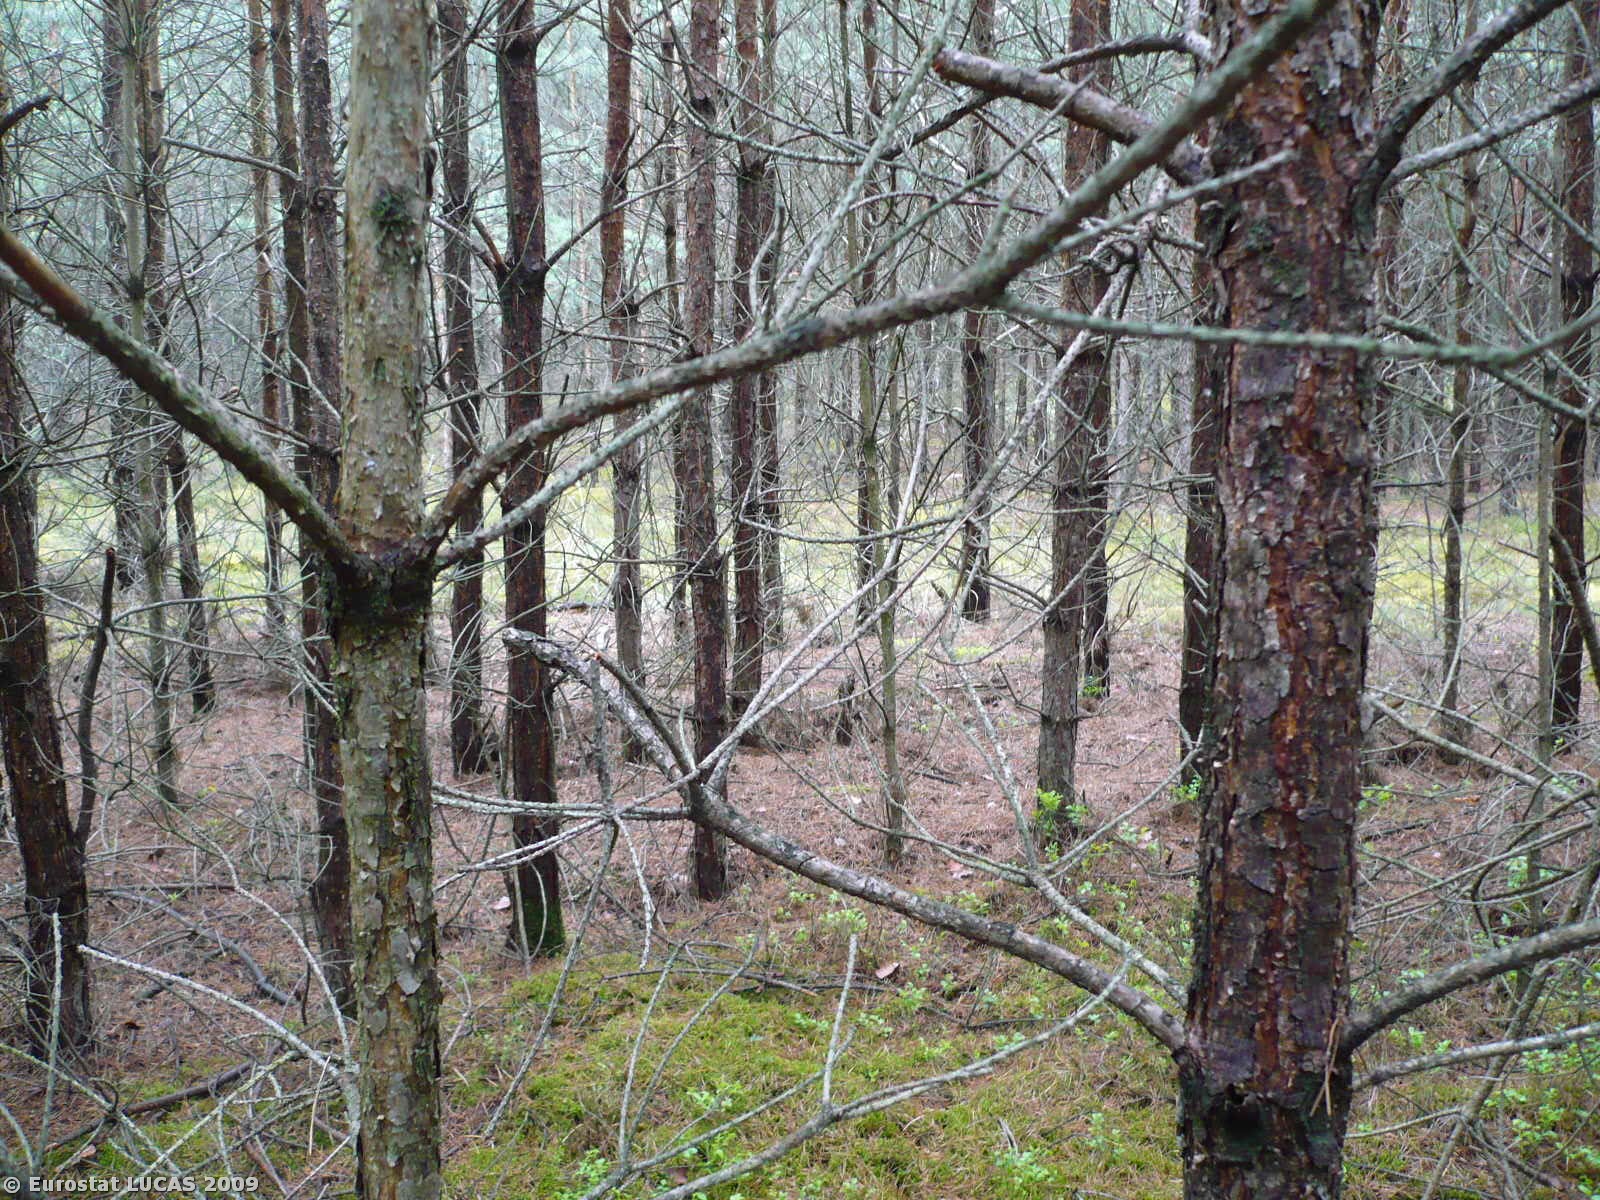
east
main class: Woodland
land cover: Coniferous woodland
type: hemiboreal forest and nemoral coniferous forest and mixed broadleaved-coniferous forest
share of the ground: > 75 %
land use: Forestry
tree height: > 5 m
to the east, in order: Coniferous woodland; Tracks; Coniferous woodland; Paved roads, cycling and walking lanes; Coniferous woodland
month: May
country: PL
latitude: 51.9702
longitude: 15.3166
